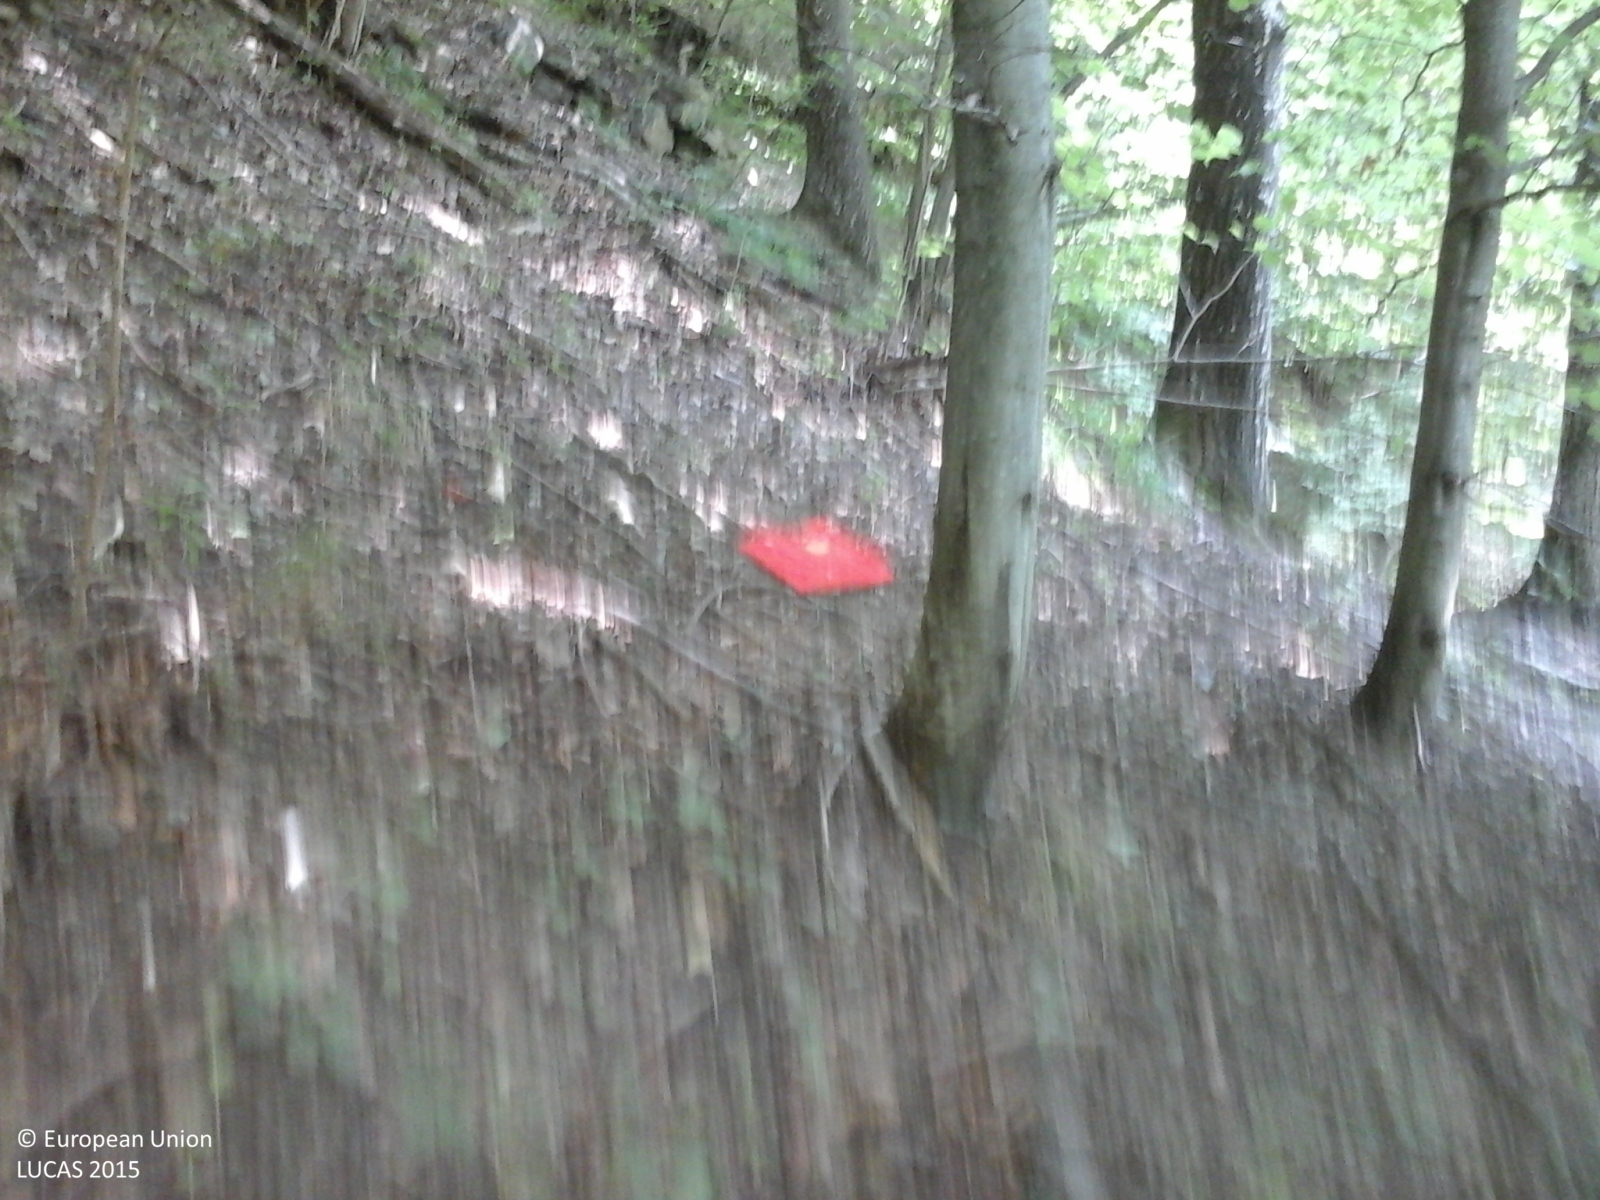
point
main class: Woodland
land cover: Broadleaved woodland
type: beech forest
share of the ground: > 75 %
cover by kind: broadleaved forest trees 100 %
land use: Semi-natural and natural areas not in use
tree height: > 5 m
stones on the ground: 10 - 25 %
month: July
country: IT
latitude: 45.2353
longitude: 7.2911
